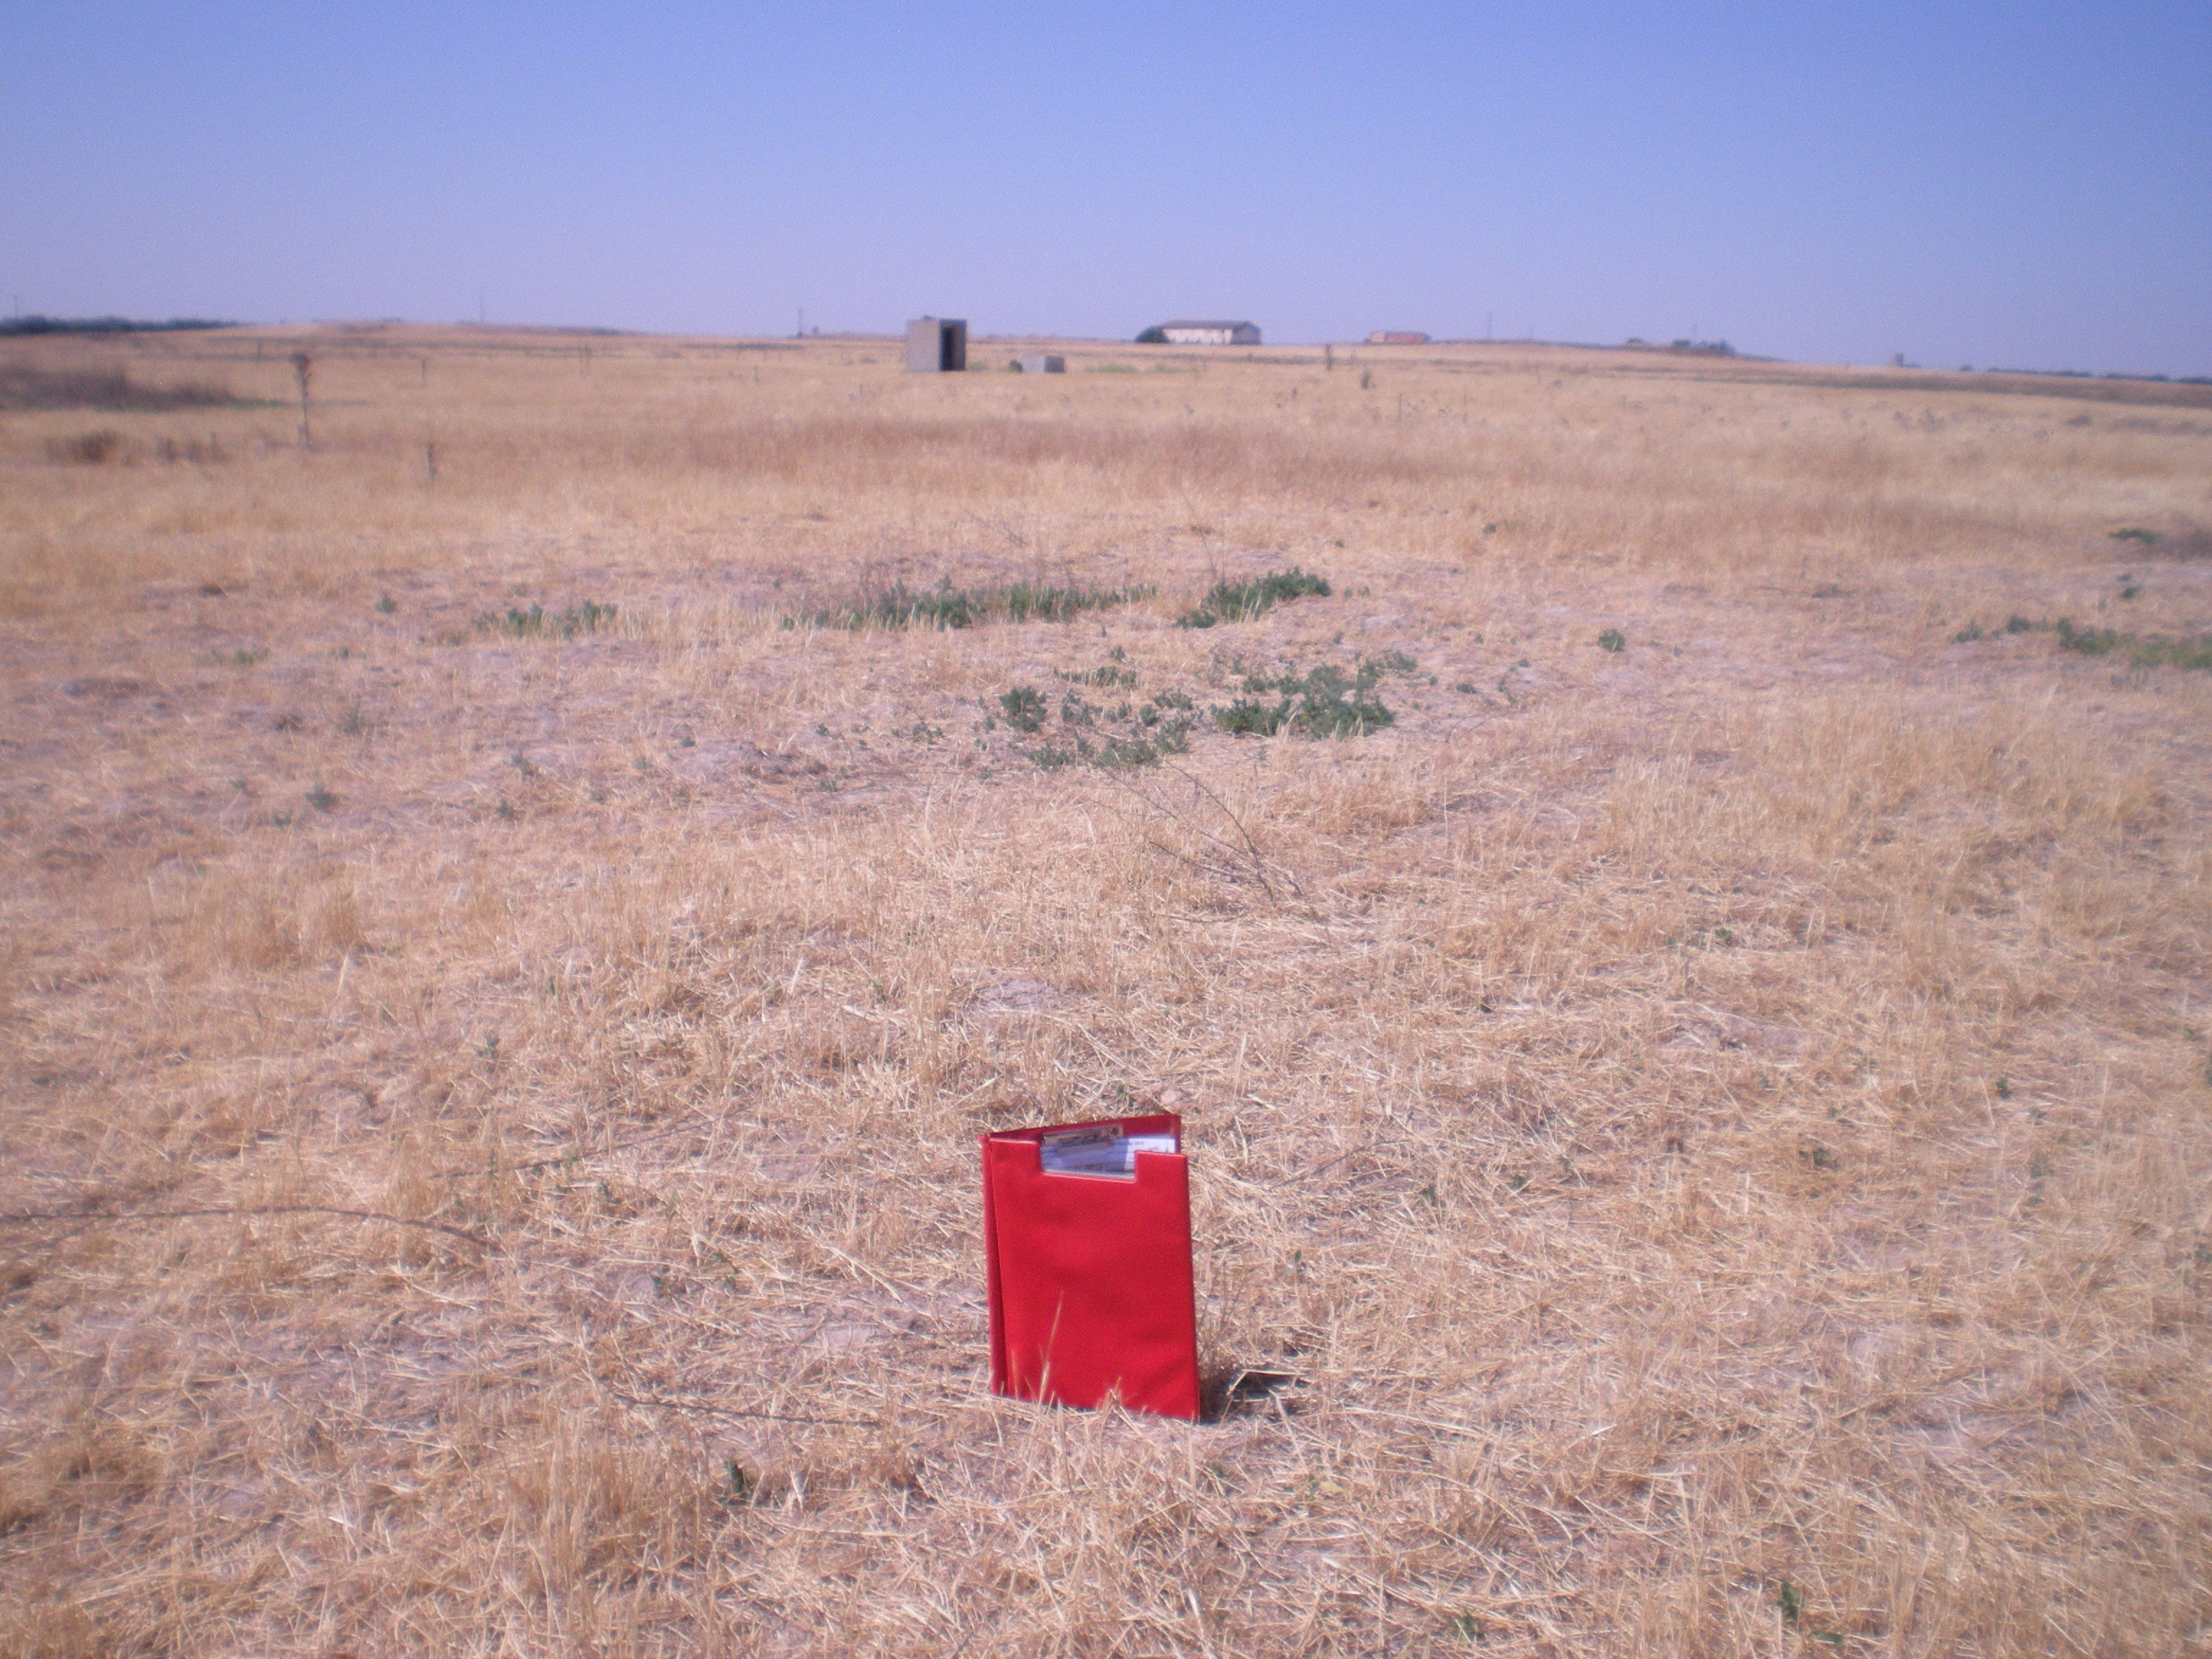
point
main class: Grassland
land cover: Grassland without tree/shrub cover
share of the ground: 10 - 25 %
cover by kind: unconsolidated bare surface 85 %, herbaceous plants 15 %
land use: Agriculture (excluding fallow land and kitchen gardens)
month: July
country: ES
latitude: 39.3387
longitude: -3.3027
